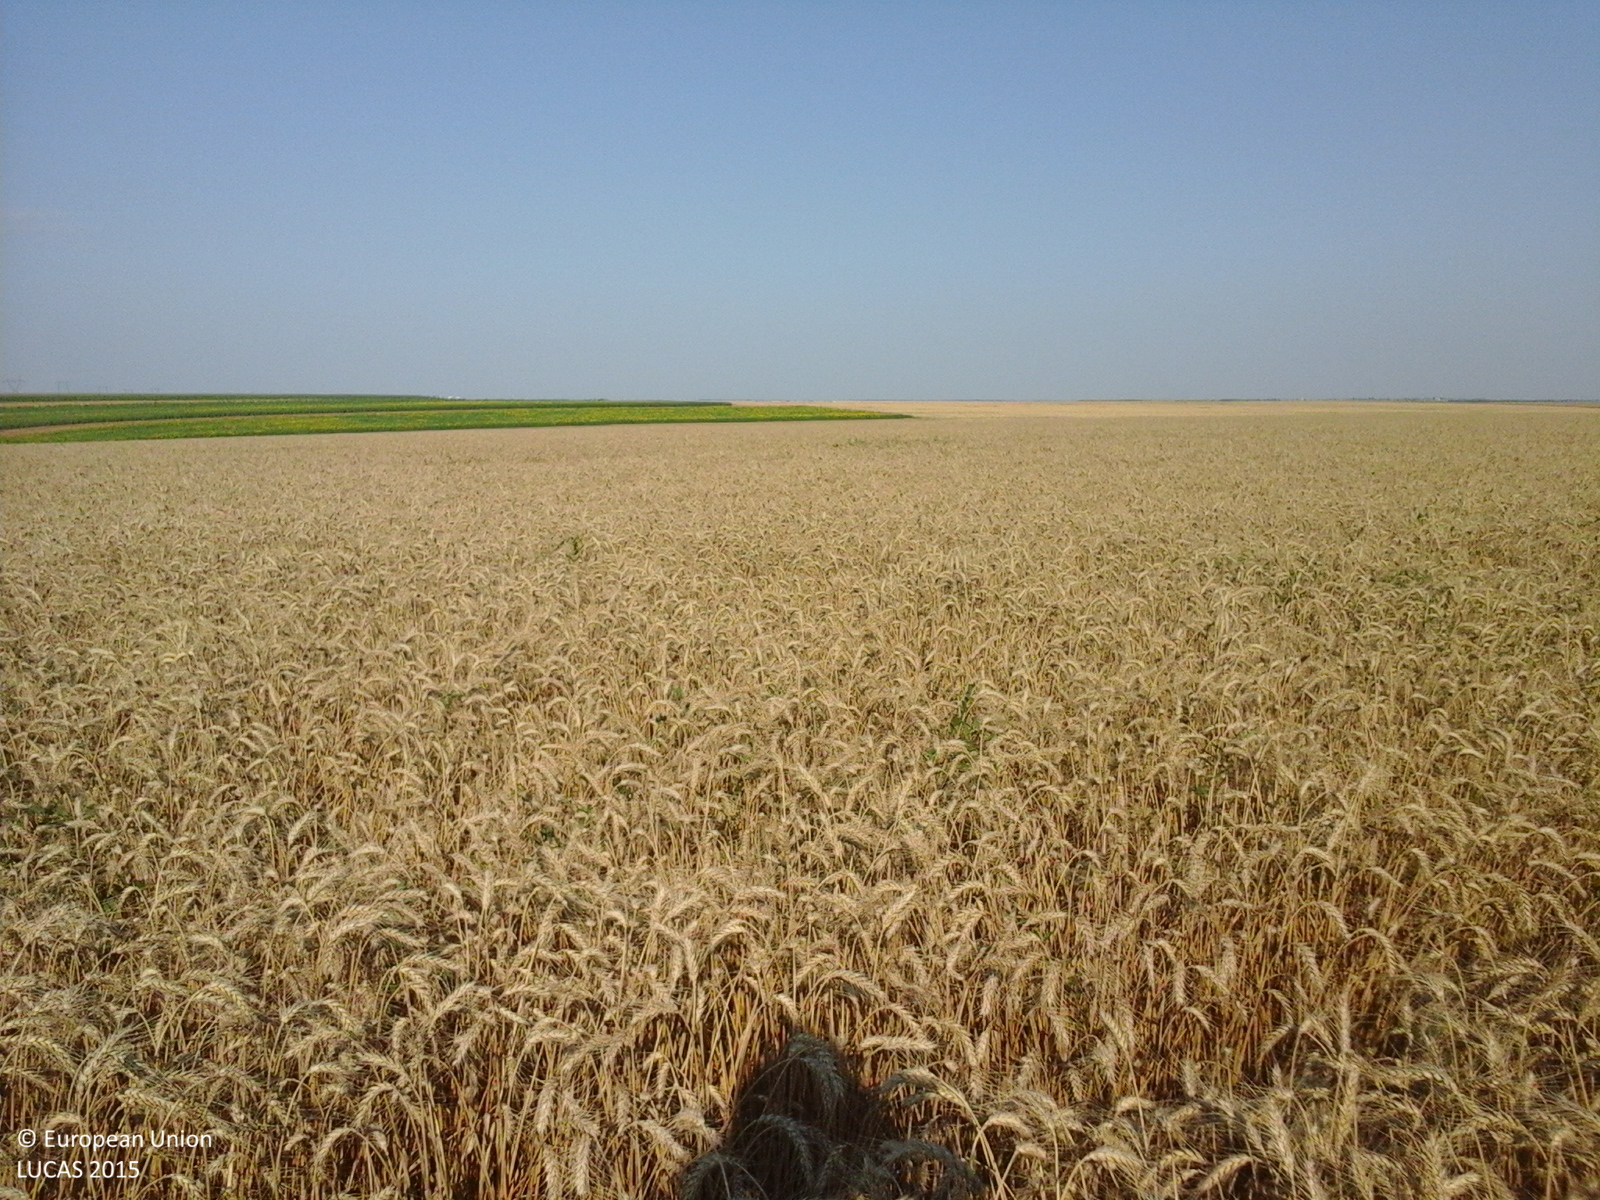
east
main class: Cropland
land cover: Common wheat
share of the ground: > 75 %
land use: Agriculture (excluding fallow land and kitchen gardens)
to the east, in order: Common wheat; Sunflower; Common wheat; Sunflower
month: July
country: RO
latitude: 44.3107
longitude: 24.6522
